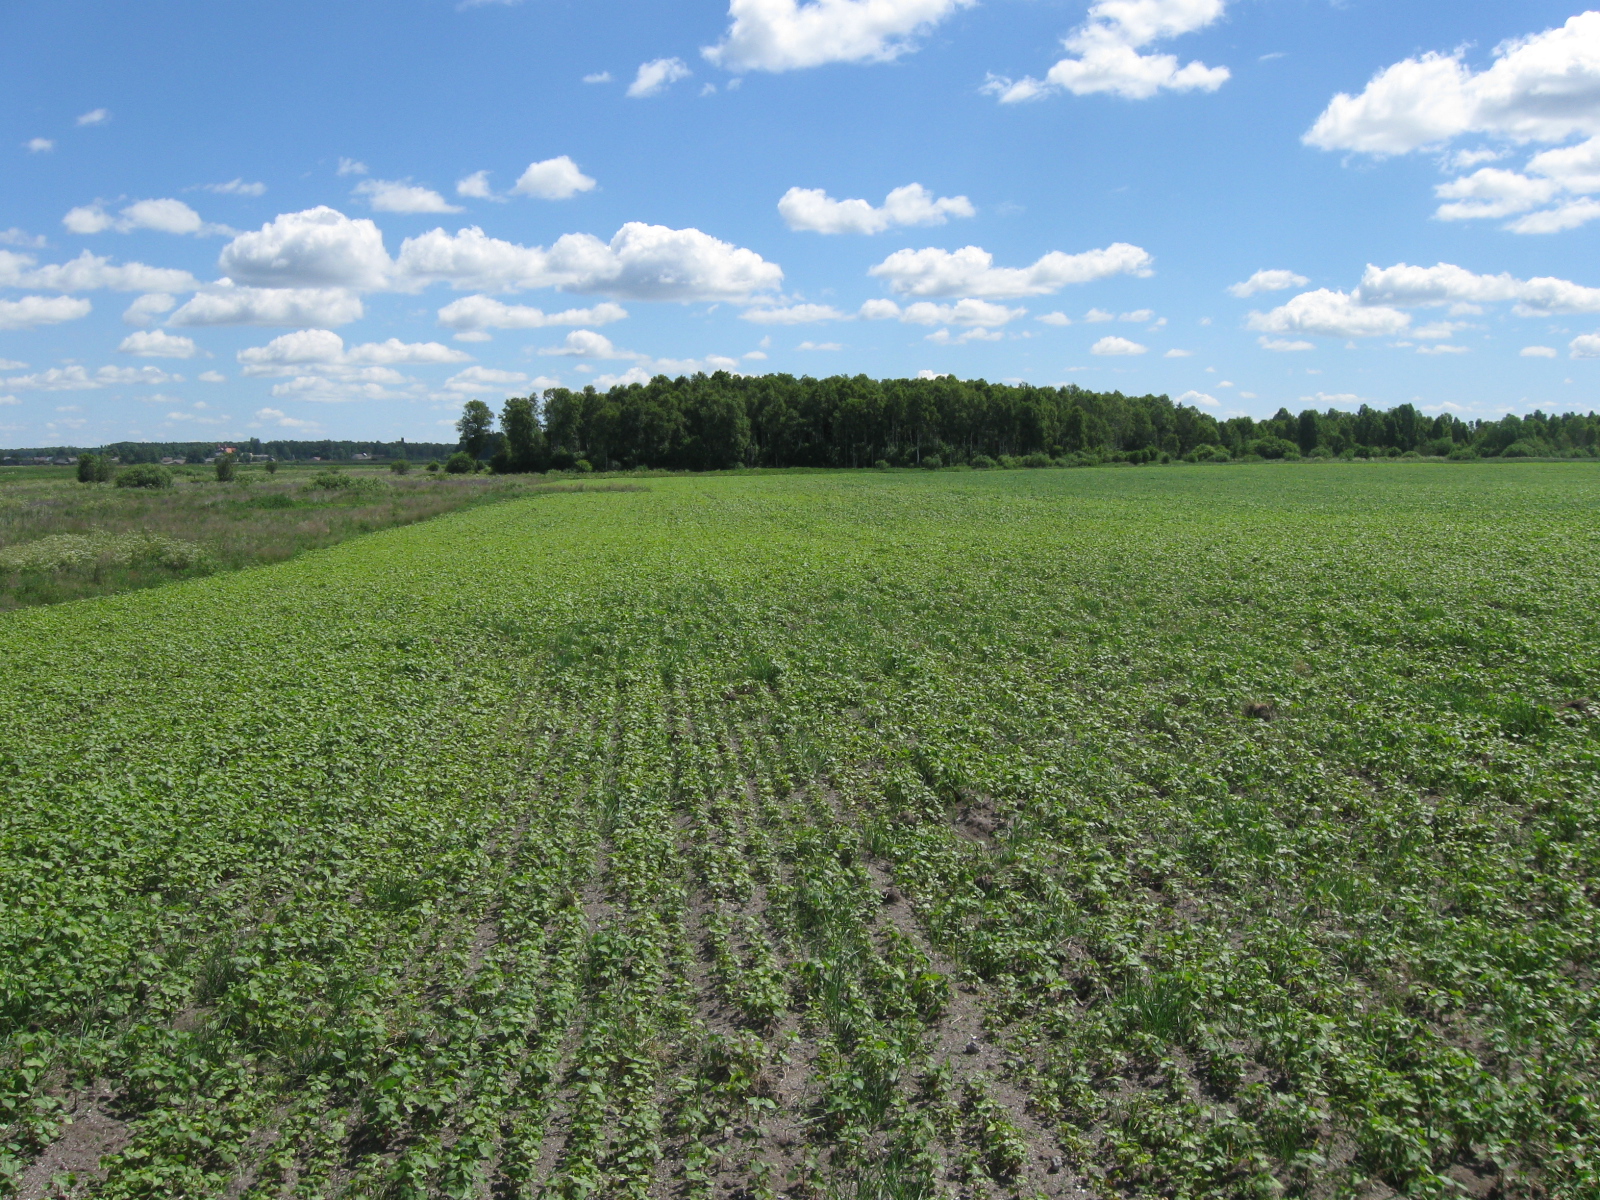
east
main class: Cropland
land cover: Other cereals
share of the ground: > 75 %
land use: Agriculture (excluding fallow land and kitchen gardens)
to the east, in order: Other cereals; Spontaneously vegetated surfaces; Ditches and canals; Spontaneously vegetated surfaces; Other cereals; Spontaneously vegetated surfaces
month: June
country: LT
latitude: 54.0149
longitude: 24.7138
